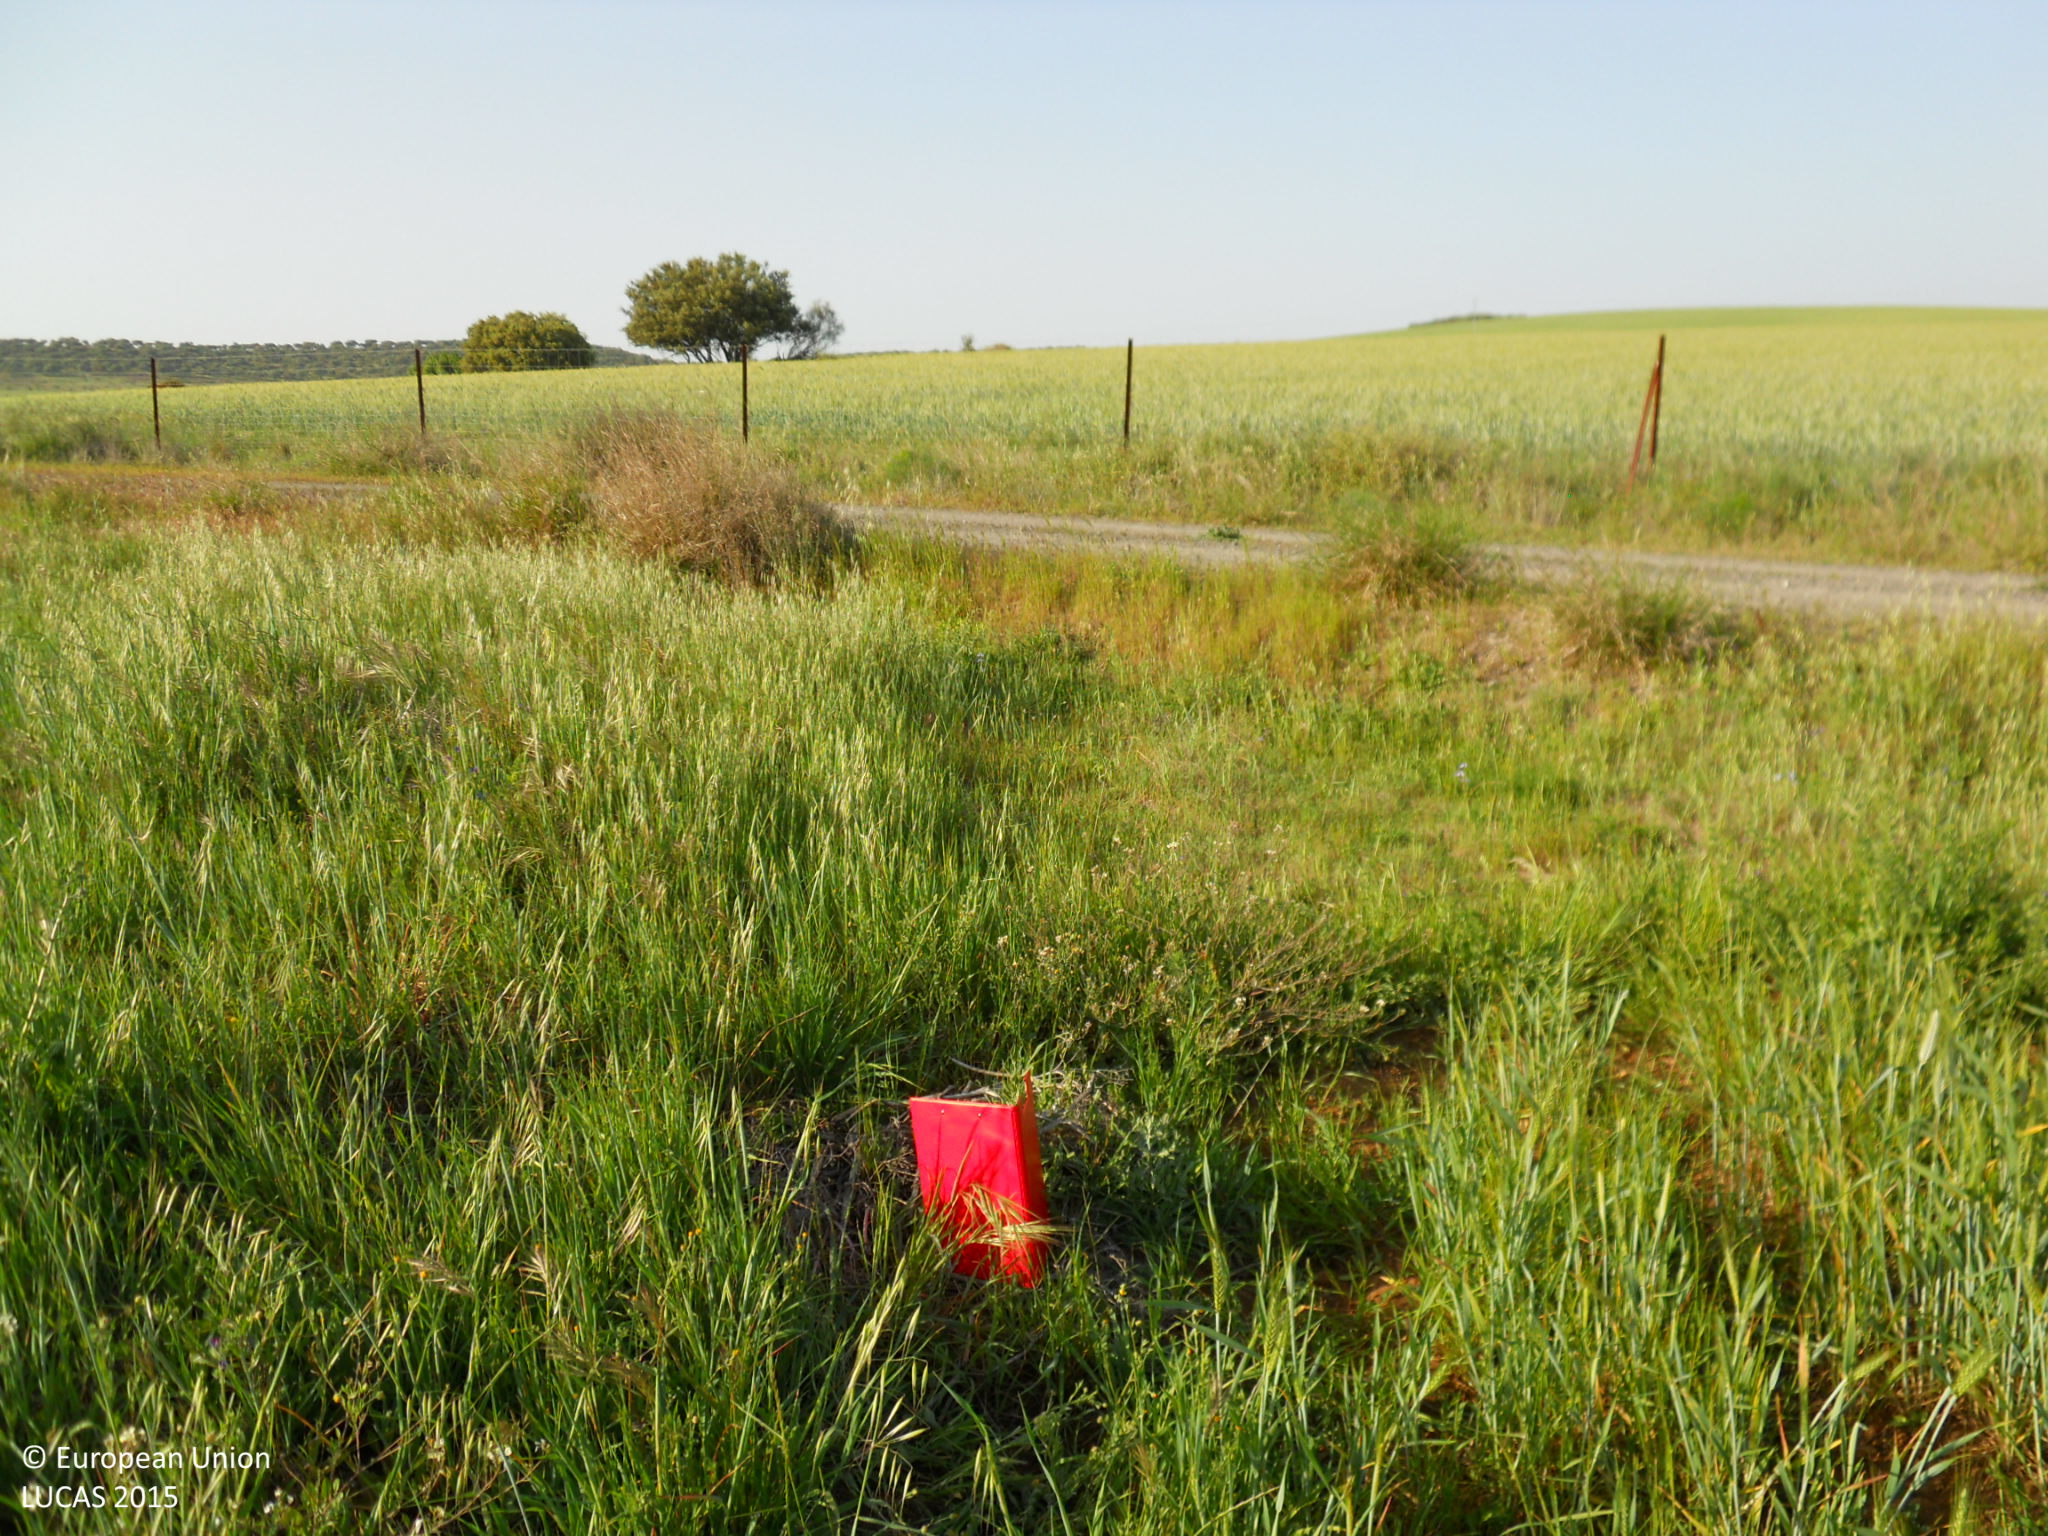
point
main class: Cropland
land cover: Barley
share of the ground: > 75 %
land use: Agriculture (excluding fallow land and kitchen gardens)
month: April
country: ES
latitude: 39.0525
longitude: -6.3414
